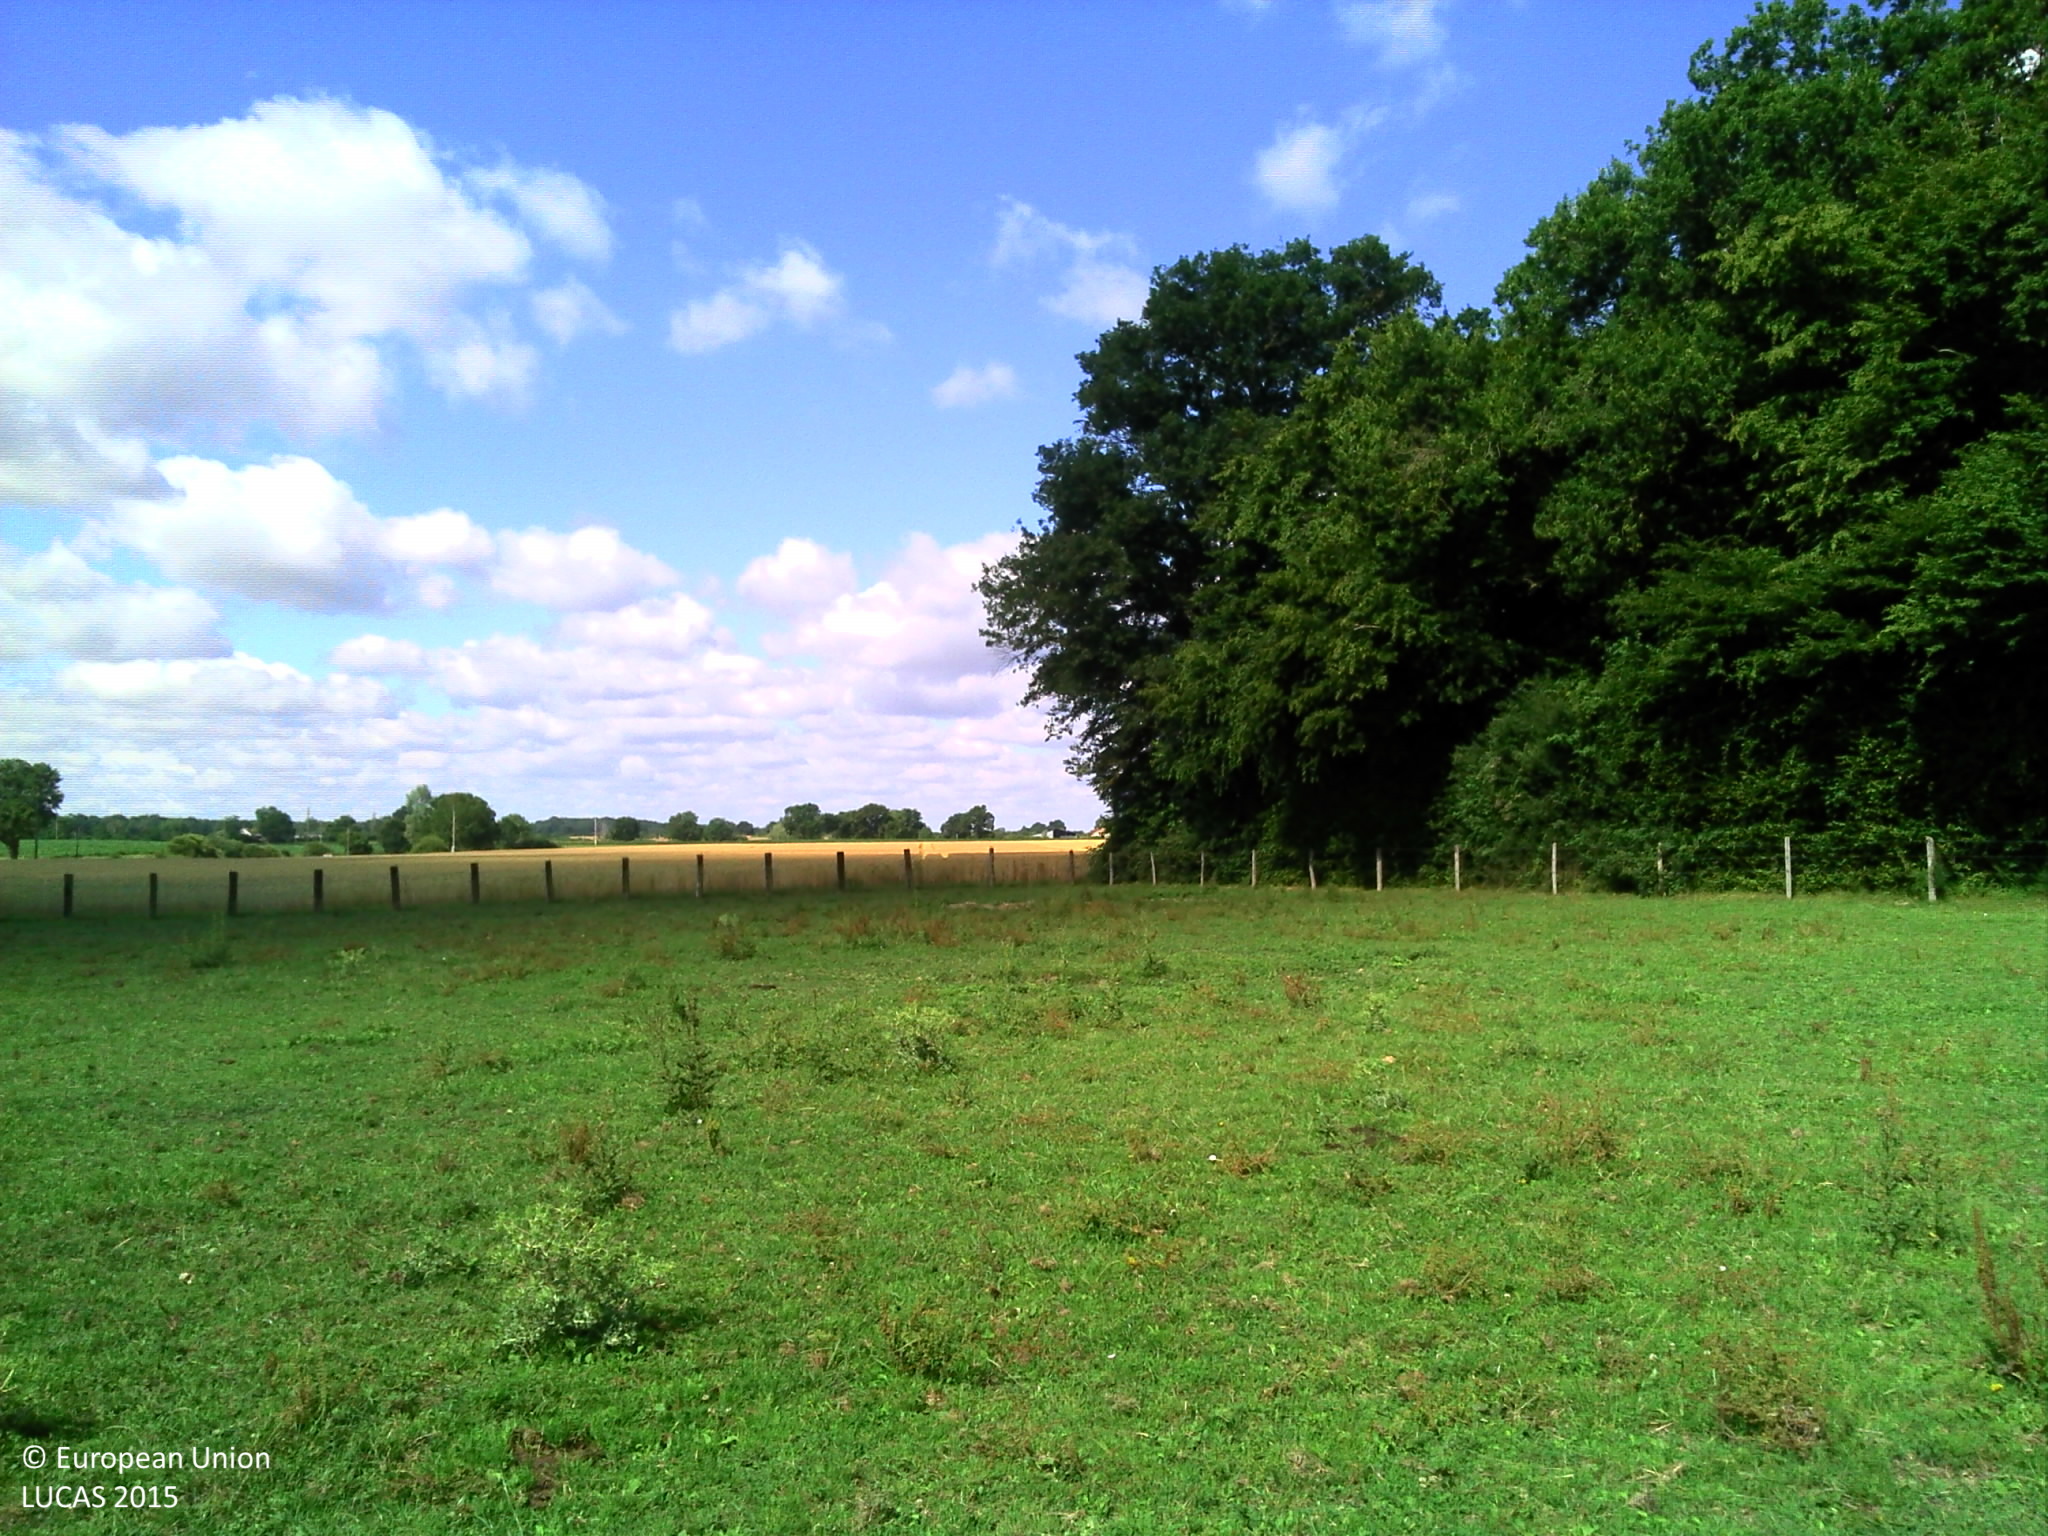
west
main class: Grassland
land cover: Grassland without tree/shrub cover
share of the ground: > 75 %
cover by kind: herbaceous plants 100 %
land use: Agriculture (excluding fallow land and kitchen gardens)
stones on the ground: < 10 %
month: June
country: FR
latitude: 46.7180
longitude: 3.5749
